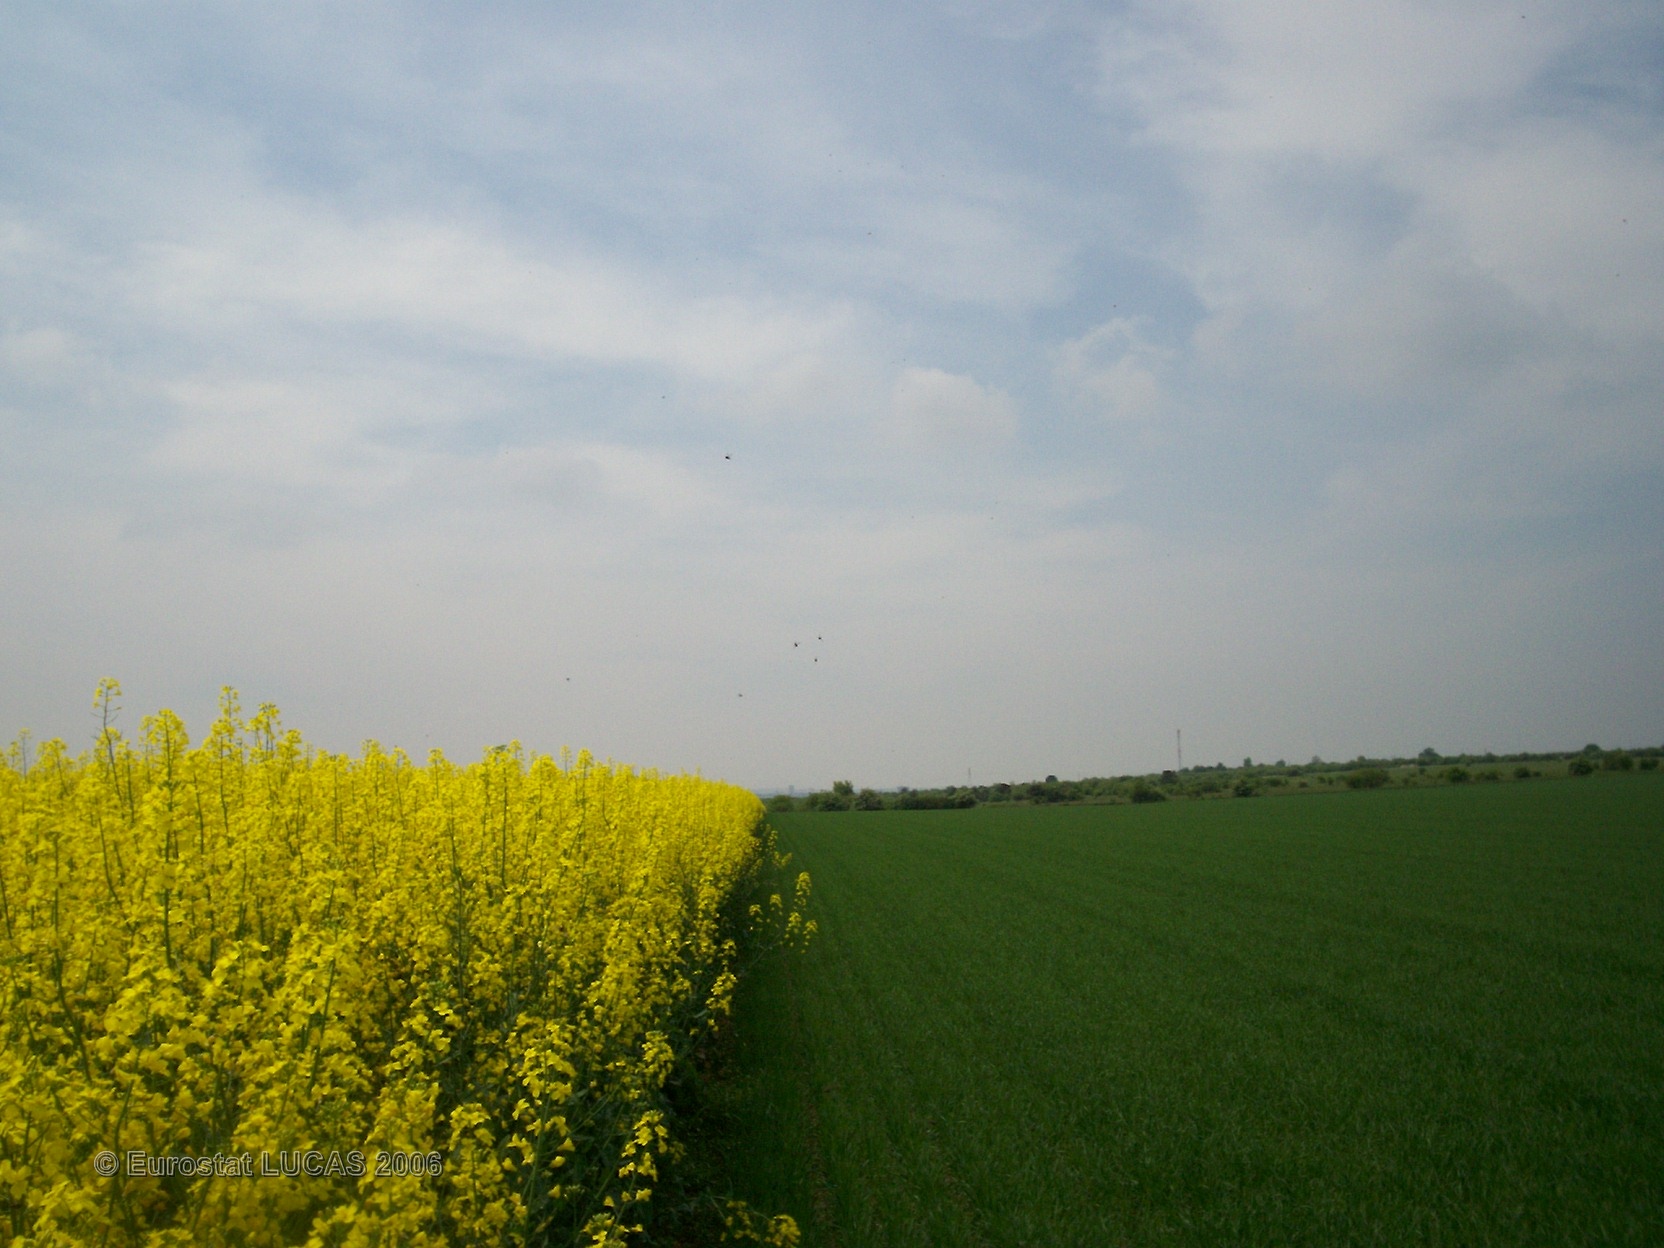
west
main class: Cropland
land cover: Rape and turnip rape
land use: Agriculture (excluding fallow land and kitchen gardens)
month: May
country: FR
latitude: 48.9847
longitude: 4.4350
